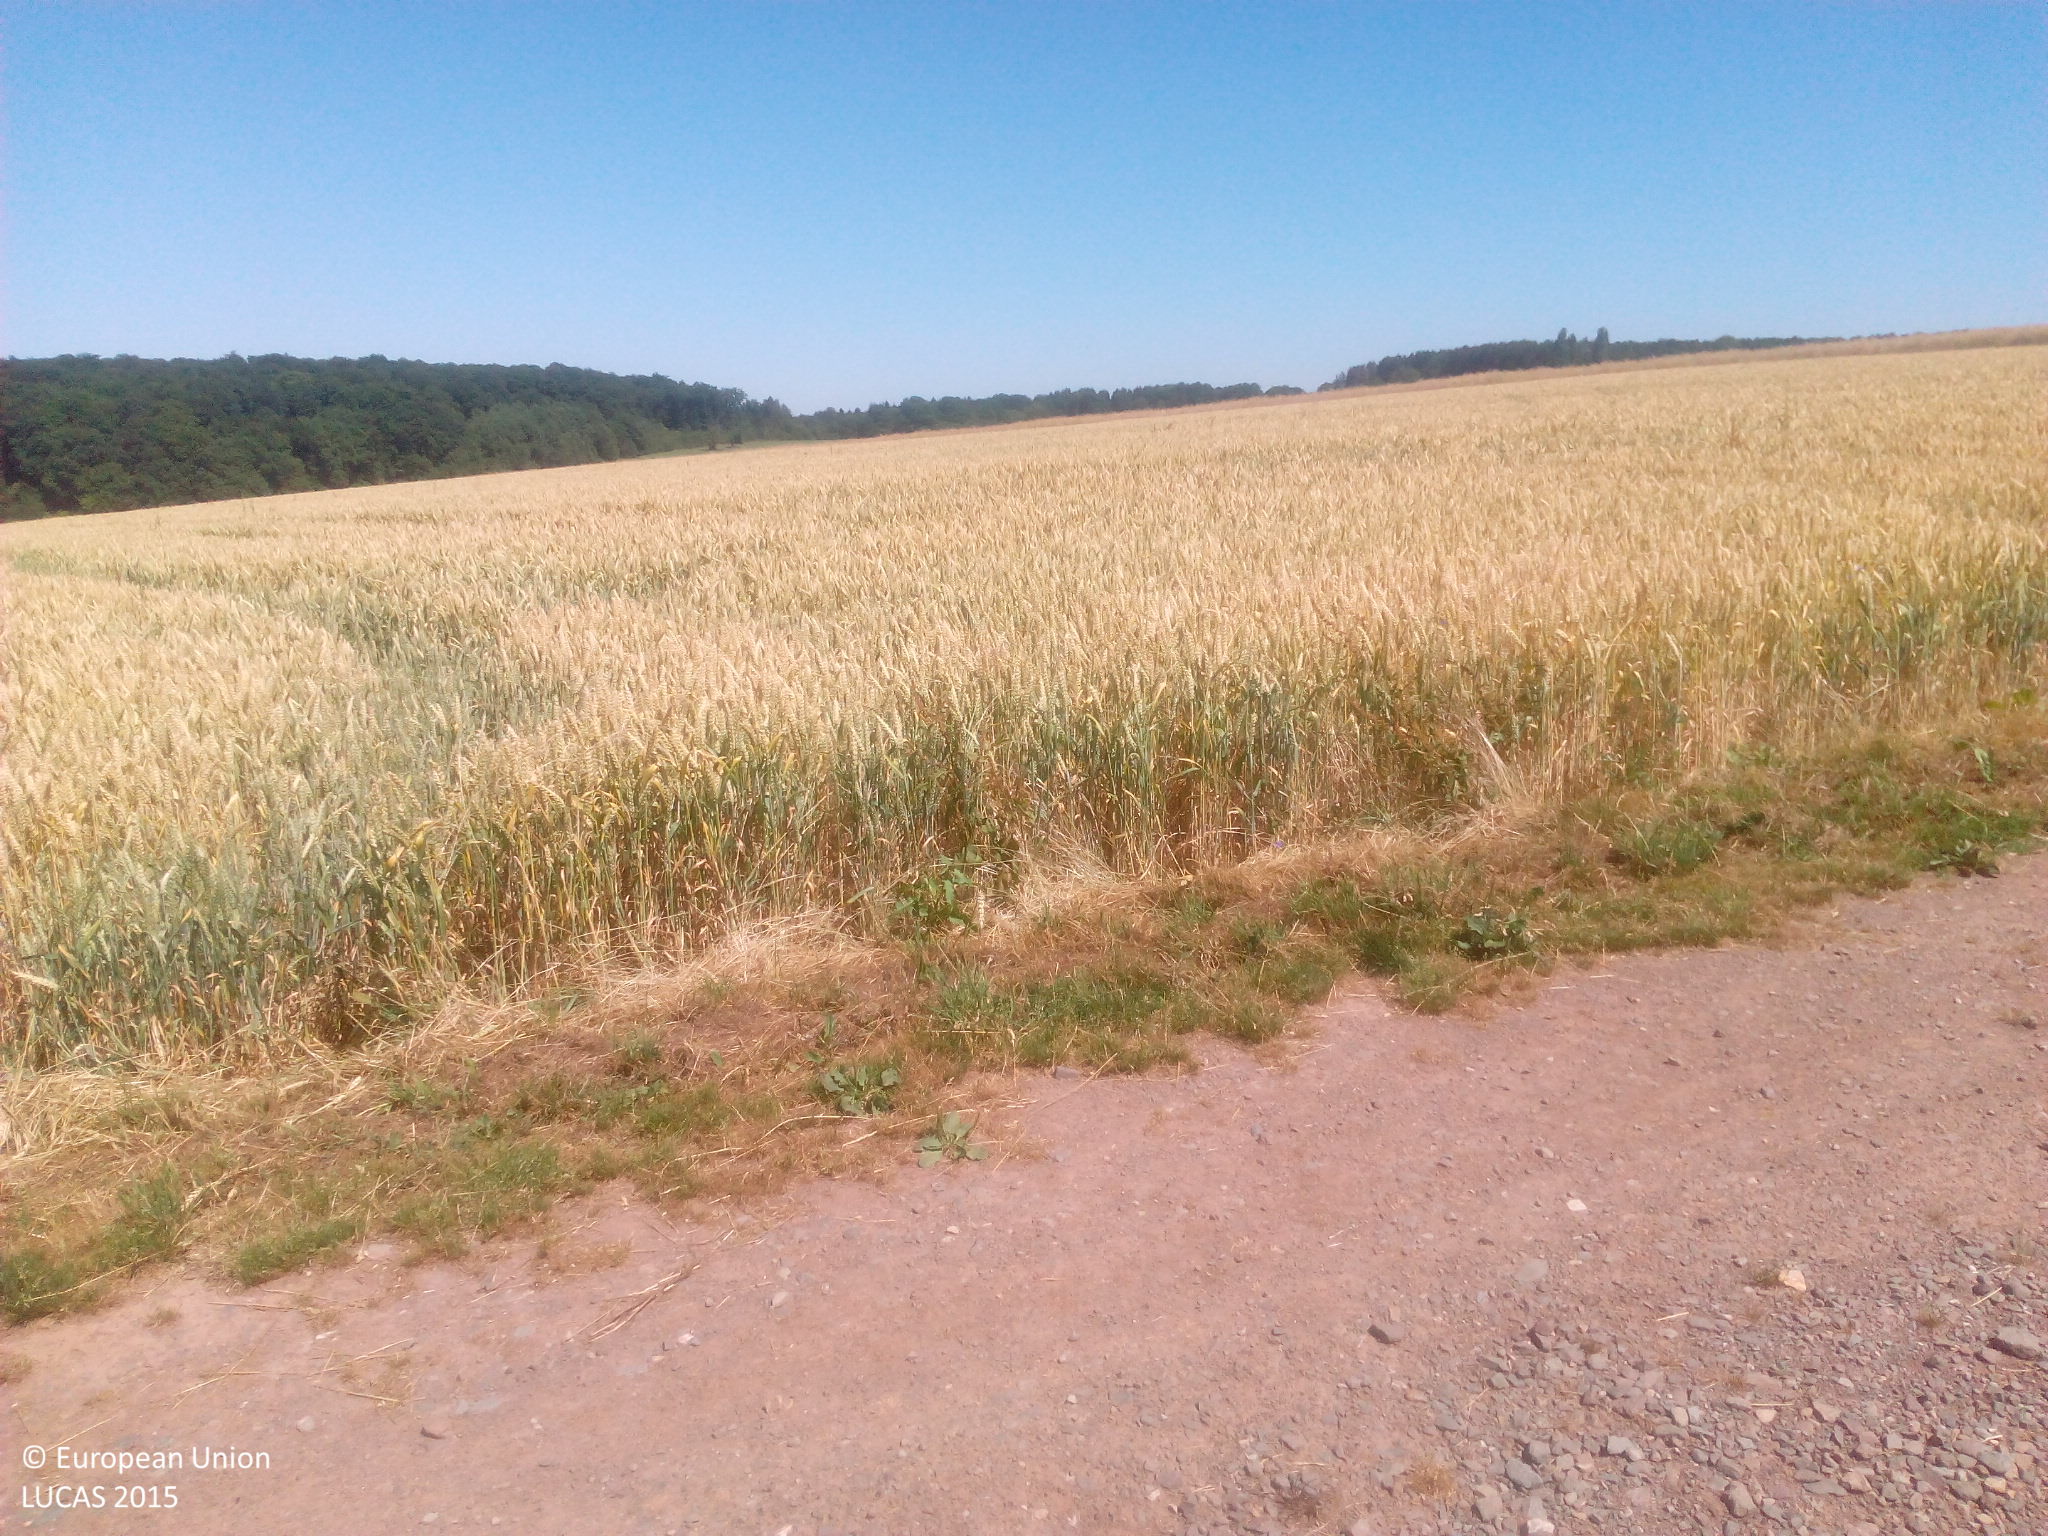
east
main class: Cropland
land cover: Common wheat
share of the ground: > 75 %
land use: Agriculture (excluding fallow land and kitchen gardens)
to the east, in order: Common wheat; Tracks; Grass margins; Common wheat; Grass margins; Tracks; Grass margins; Rape and turnip rape
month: July
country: DE
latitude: 49.4273
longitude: 7.0911
